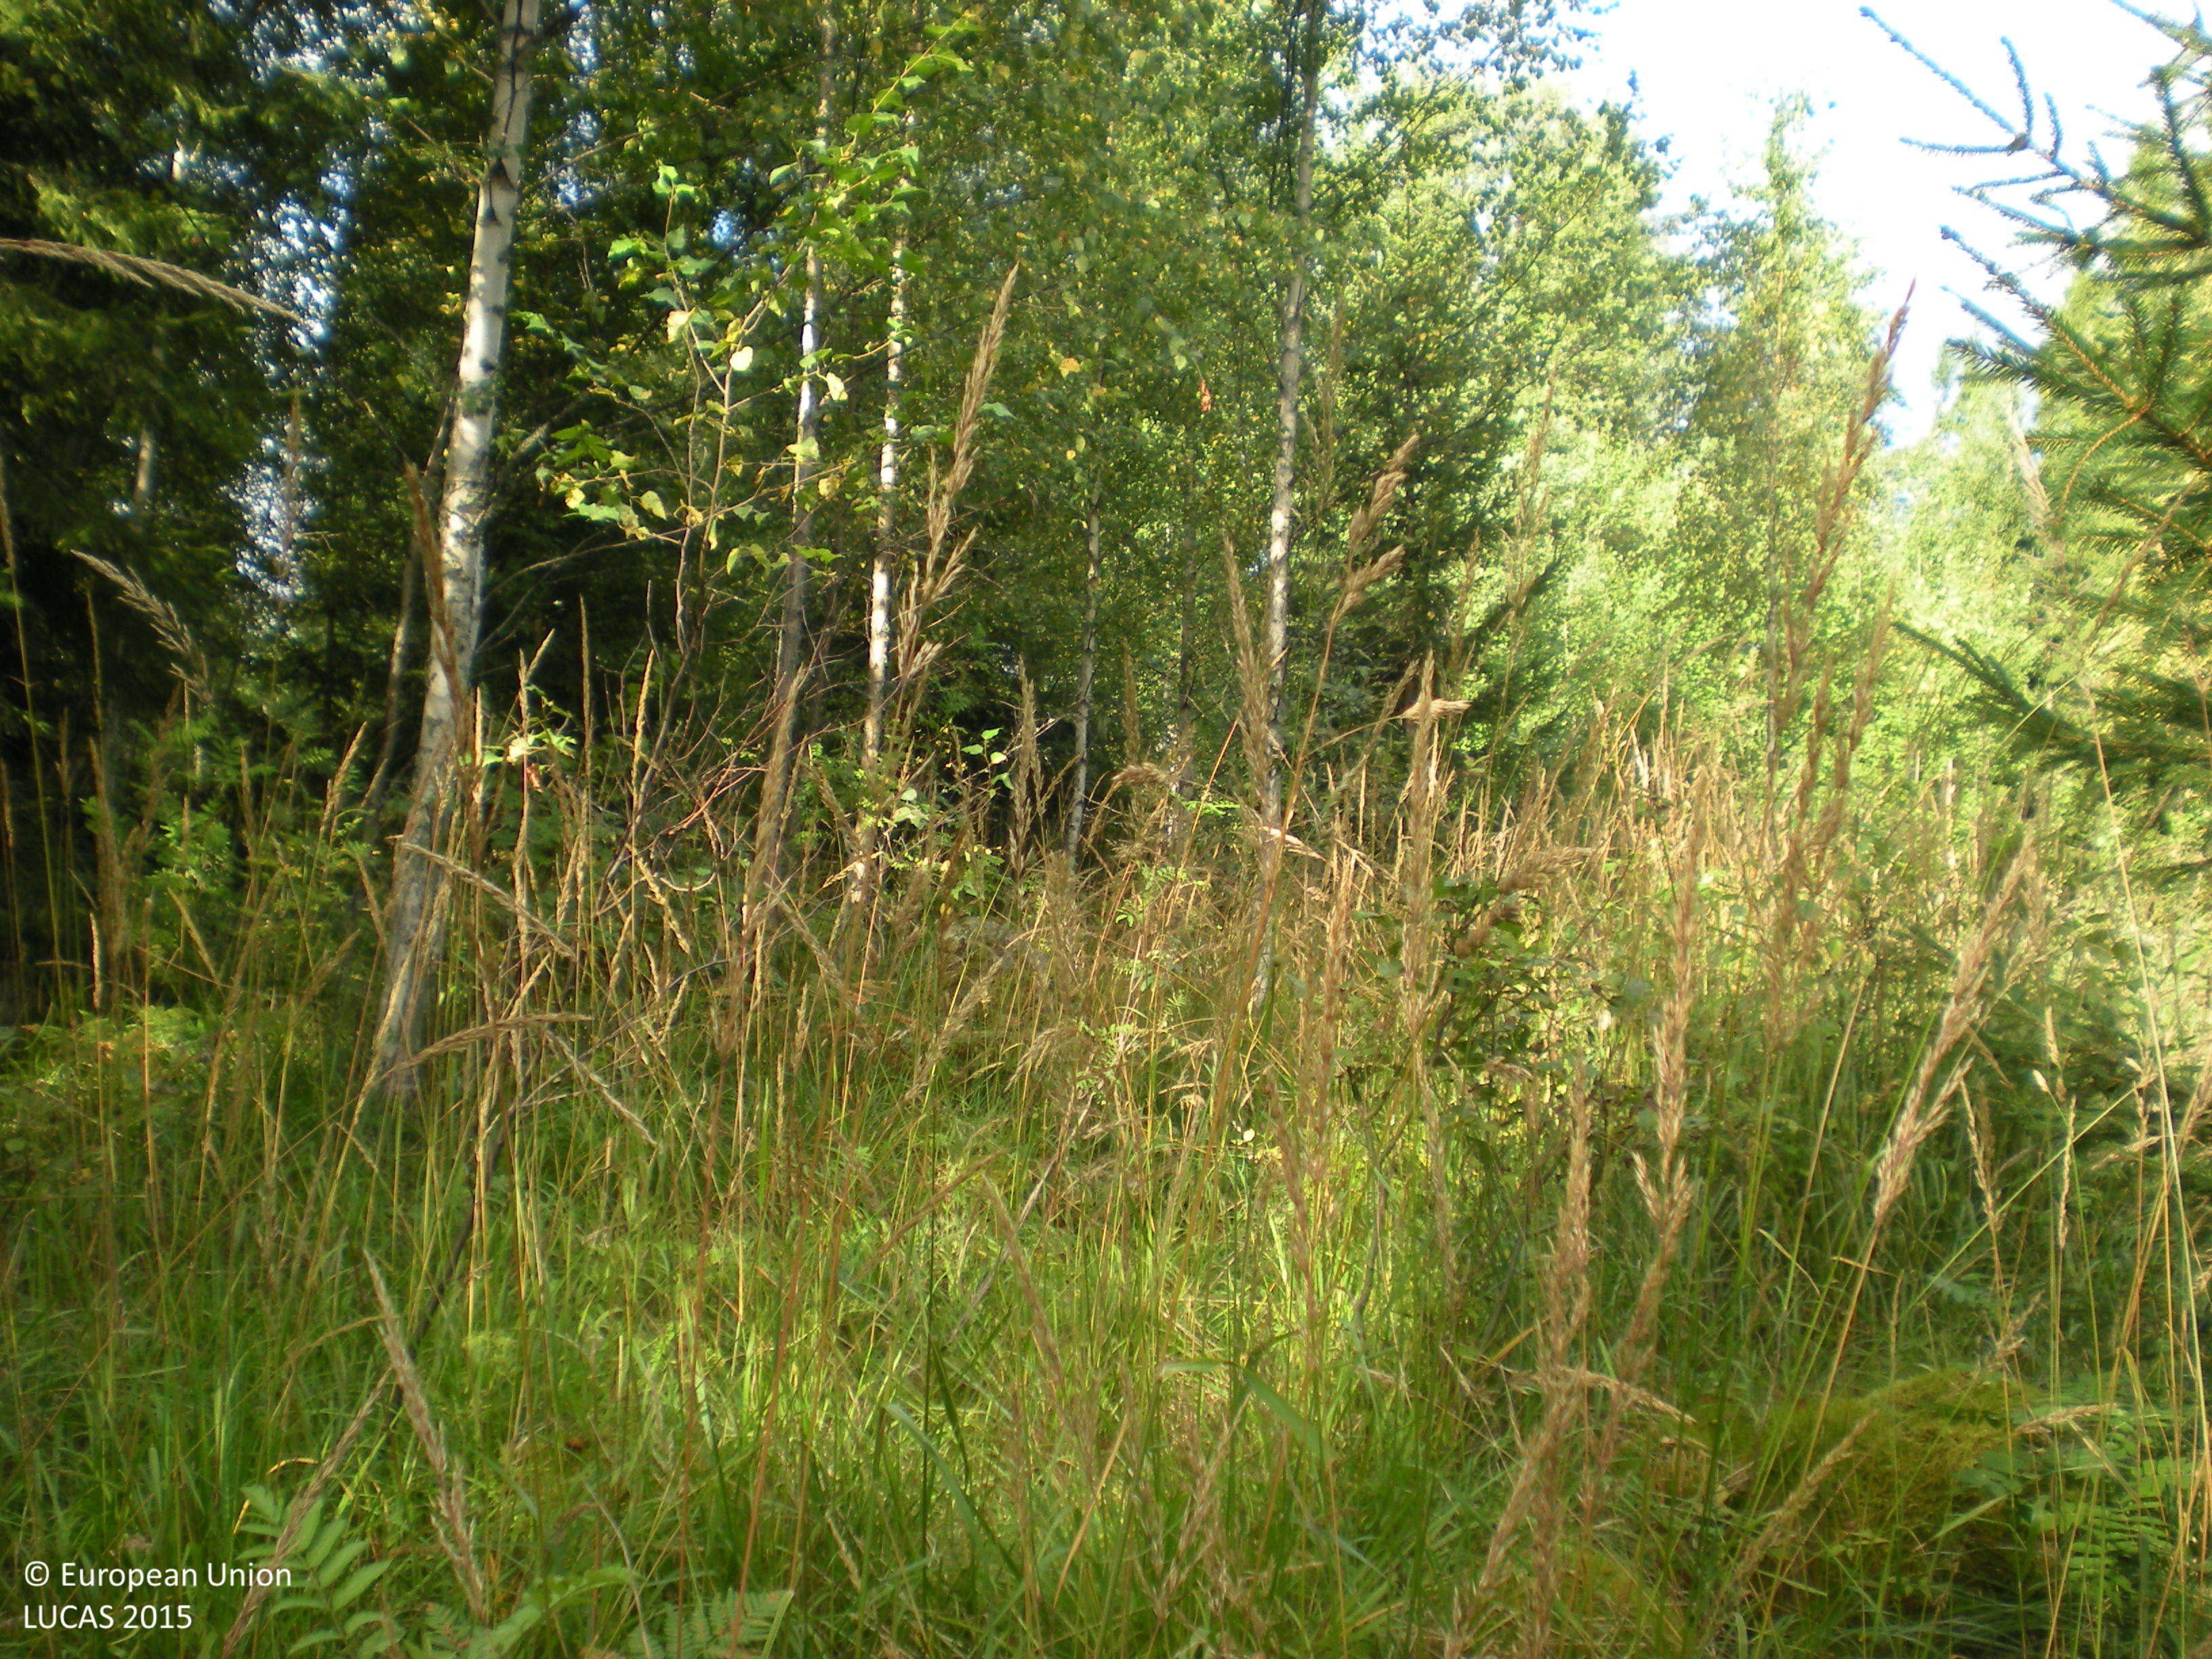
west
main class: Woodland
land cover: Spruce dominated mixed woodland
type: boreal forest
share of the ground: 50 - 75 %
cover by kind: herbaceous plants 35 %, coniferous forest trees 30 %, broadleaved forest trees 25 %, shrubs 5 %, lichens and mosses 5 %
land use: Forestry
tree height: > 5 m
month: August
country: SE
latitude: 60.4522
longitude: 17.1343
